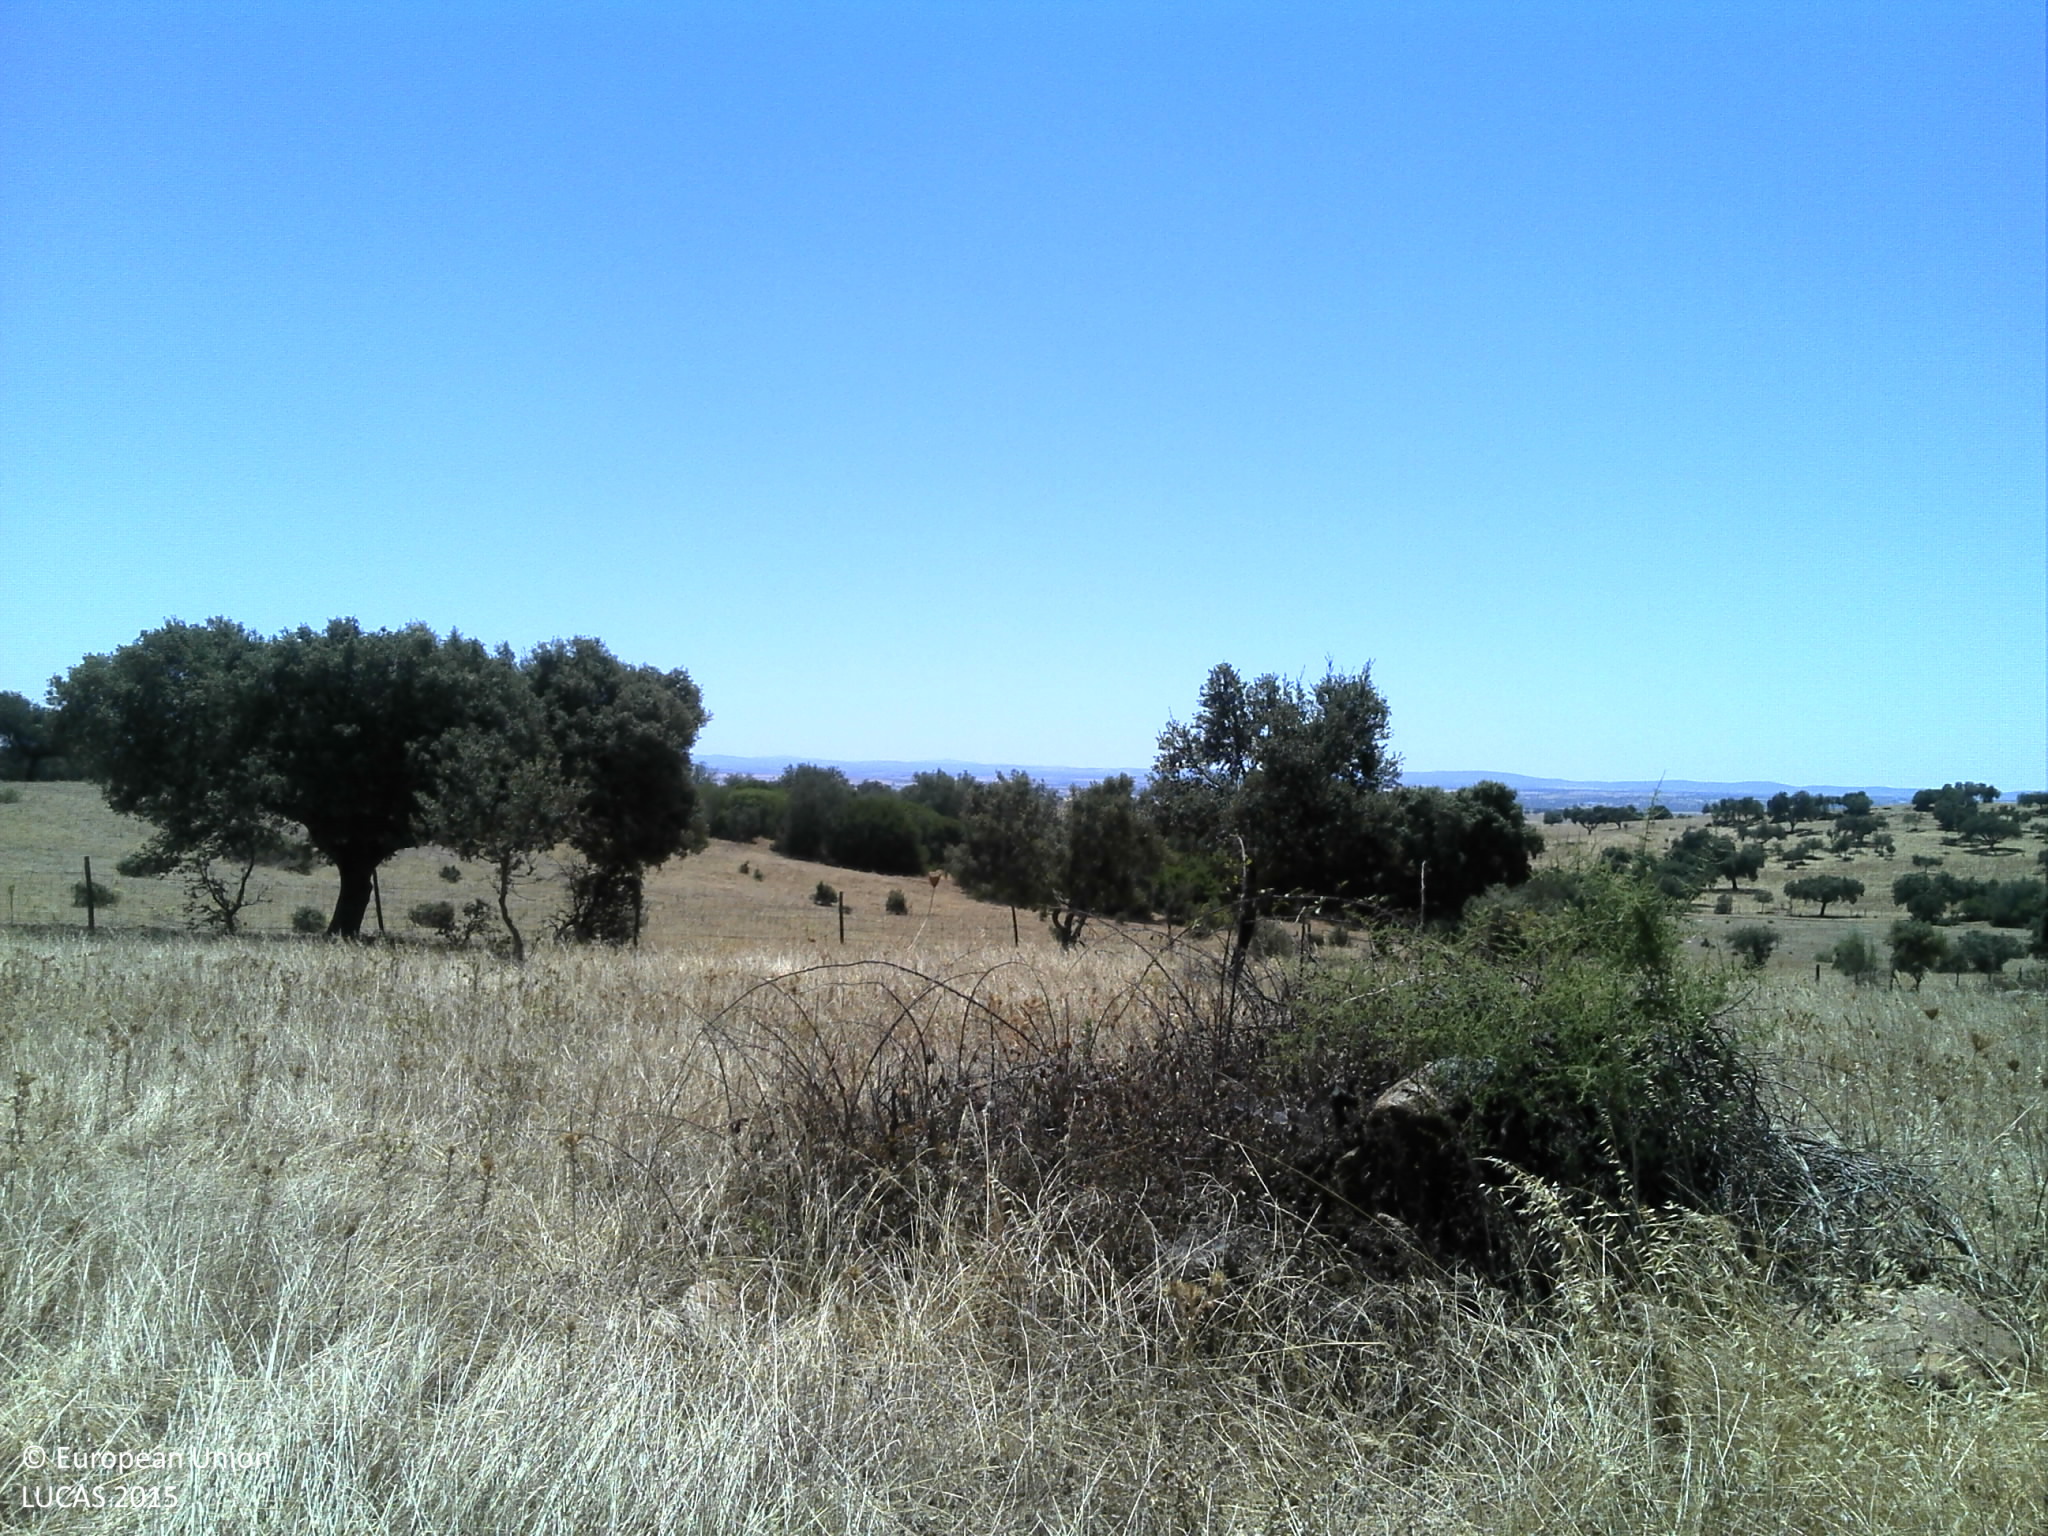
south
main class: Woodland
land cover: Broadleaved woodland
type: broadleaved evergreen forest
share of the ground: 10 - 25 %
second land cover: Grassland without tree/shrub cover
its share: 25 - 50 %
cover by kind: unconsolidated bare surface 55 %, herbaceous plants 25 %, broadleaved forest trees 20 %
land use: Forestry
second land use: Agriculture (excluding fallow land and kitchen gardens)
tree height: > 5 m
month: July
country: PT
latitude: 39.1299
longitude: -7.5670
